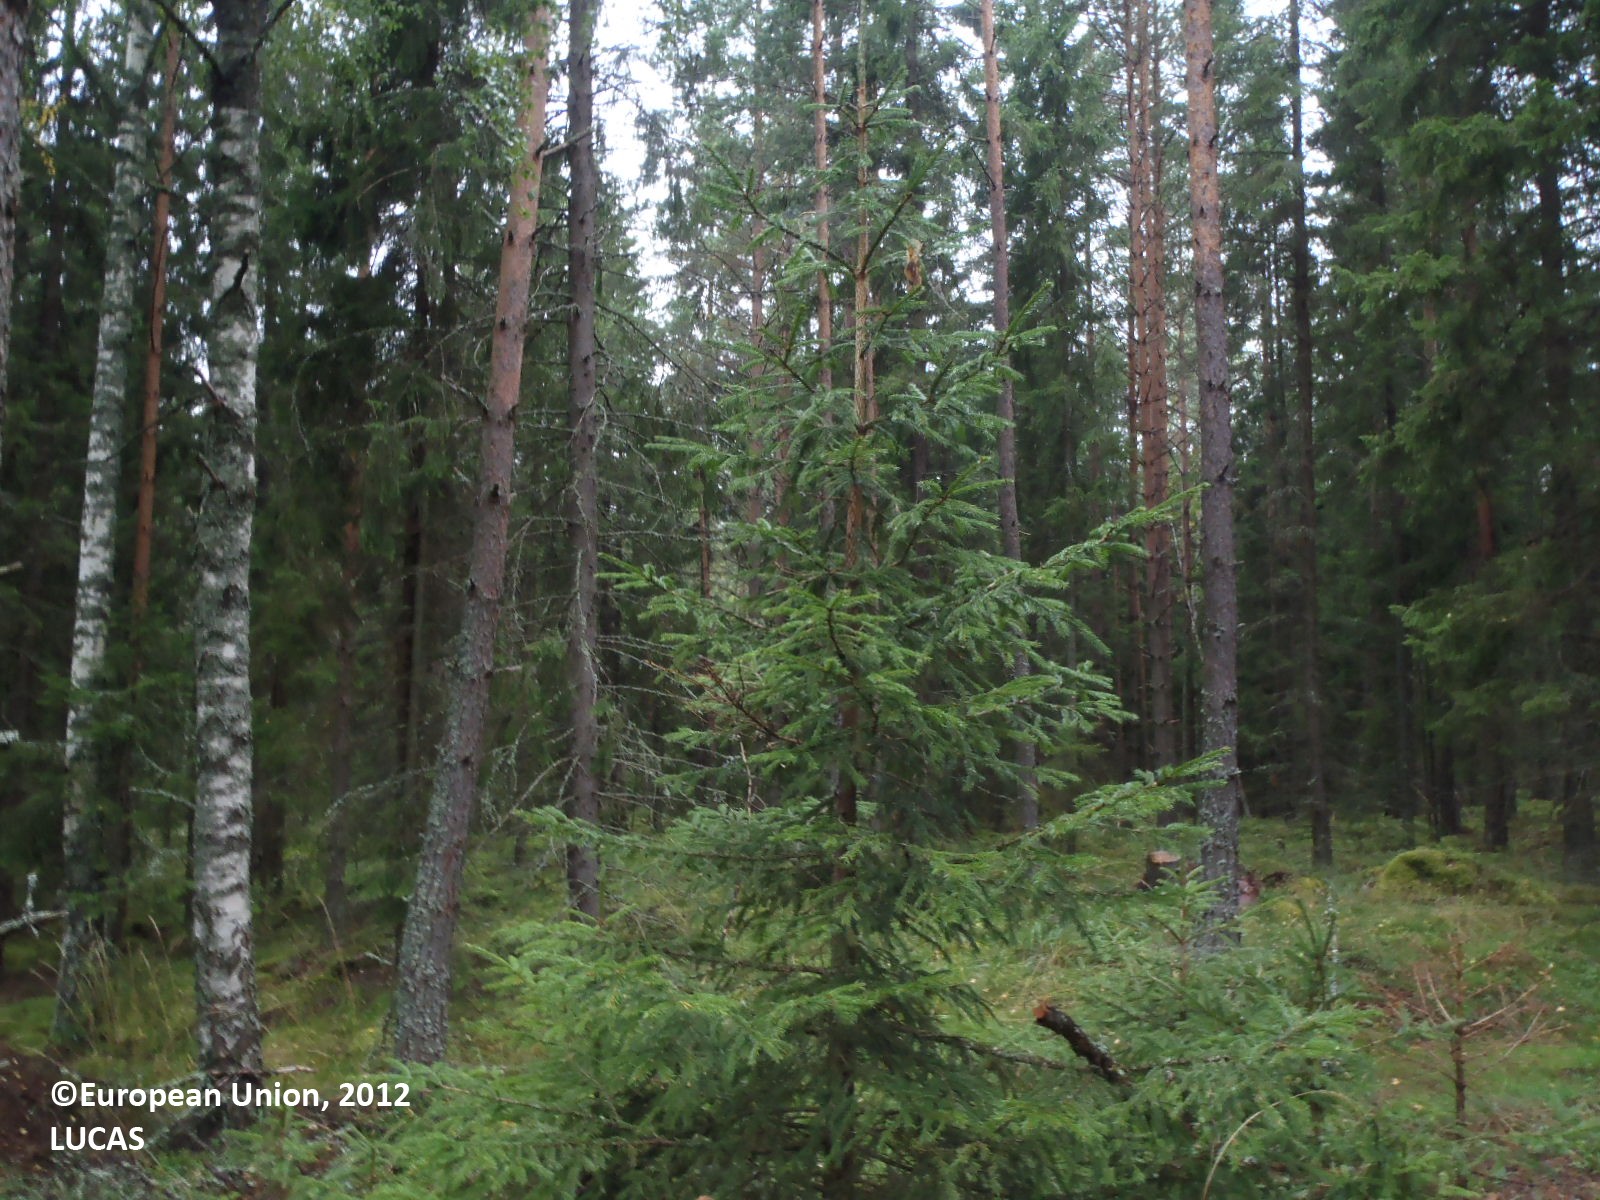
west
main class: Woodland
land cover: Pine dominated coniferous woodland
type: boreal forest
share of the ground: 50 - 75 %
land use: Forestry
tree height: > 5 m
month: September
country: FI
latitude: 60.8531
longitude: 22.8283
